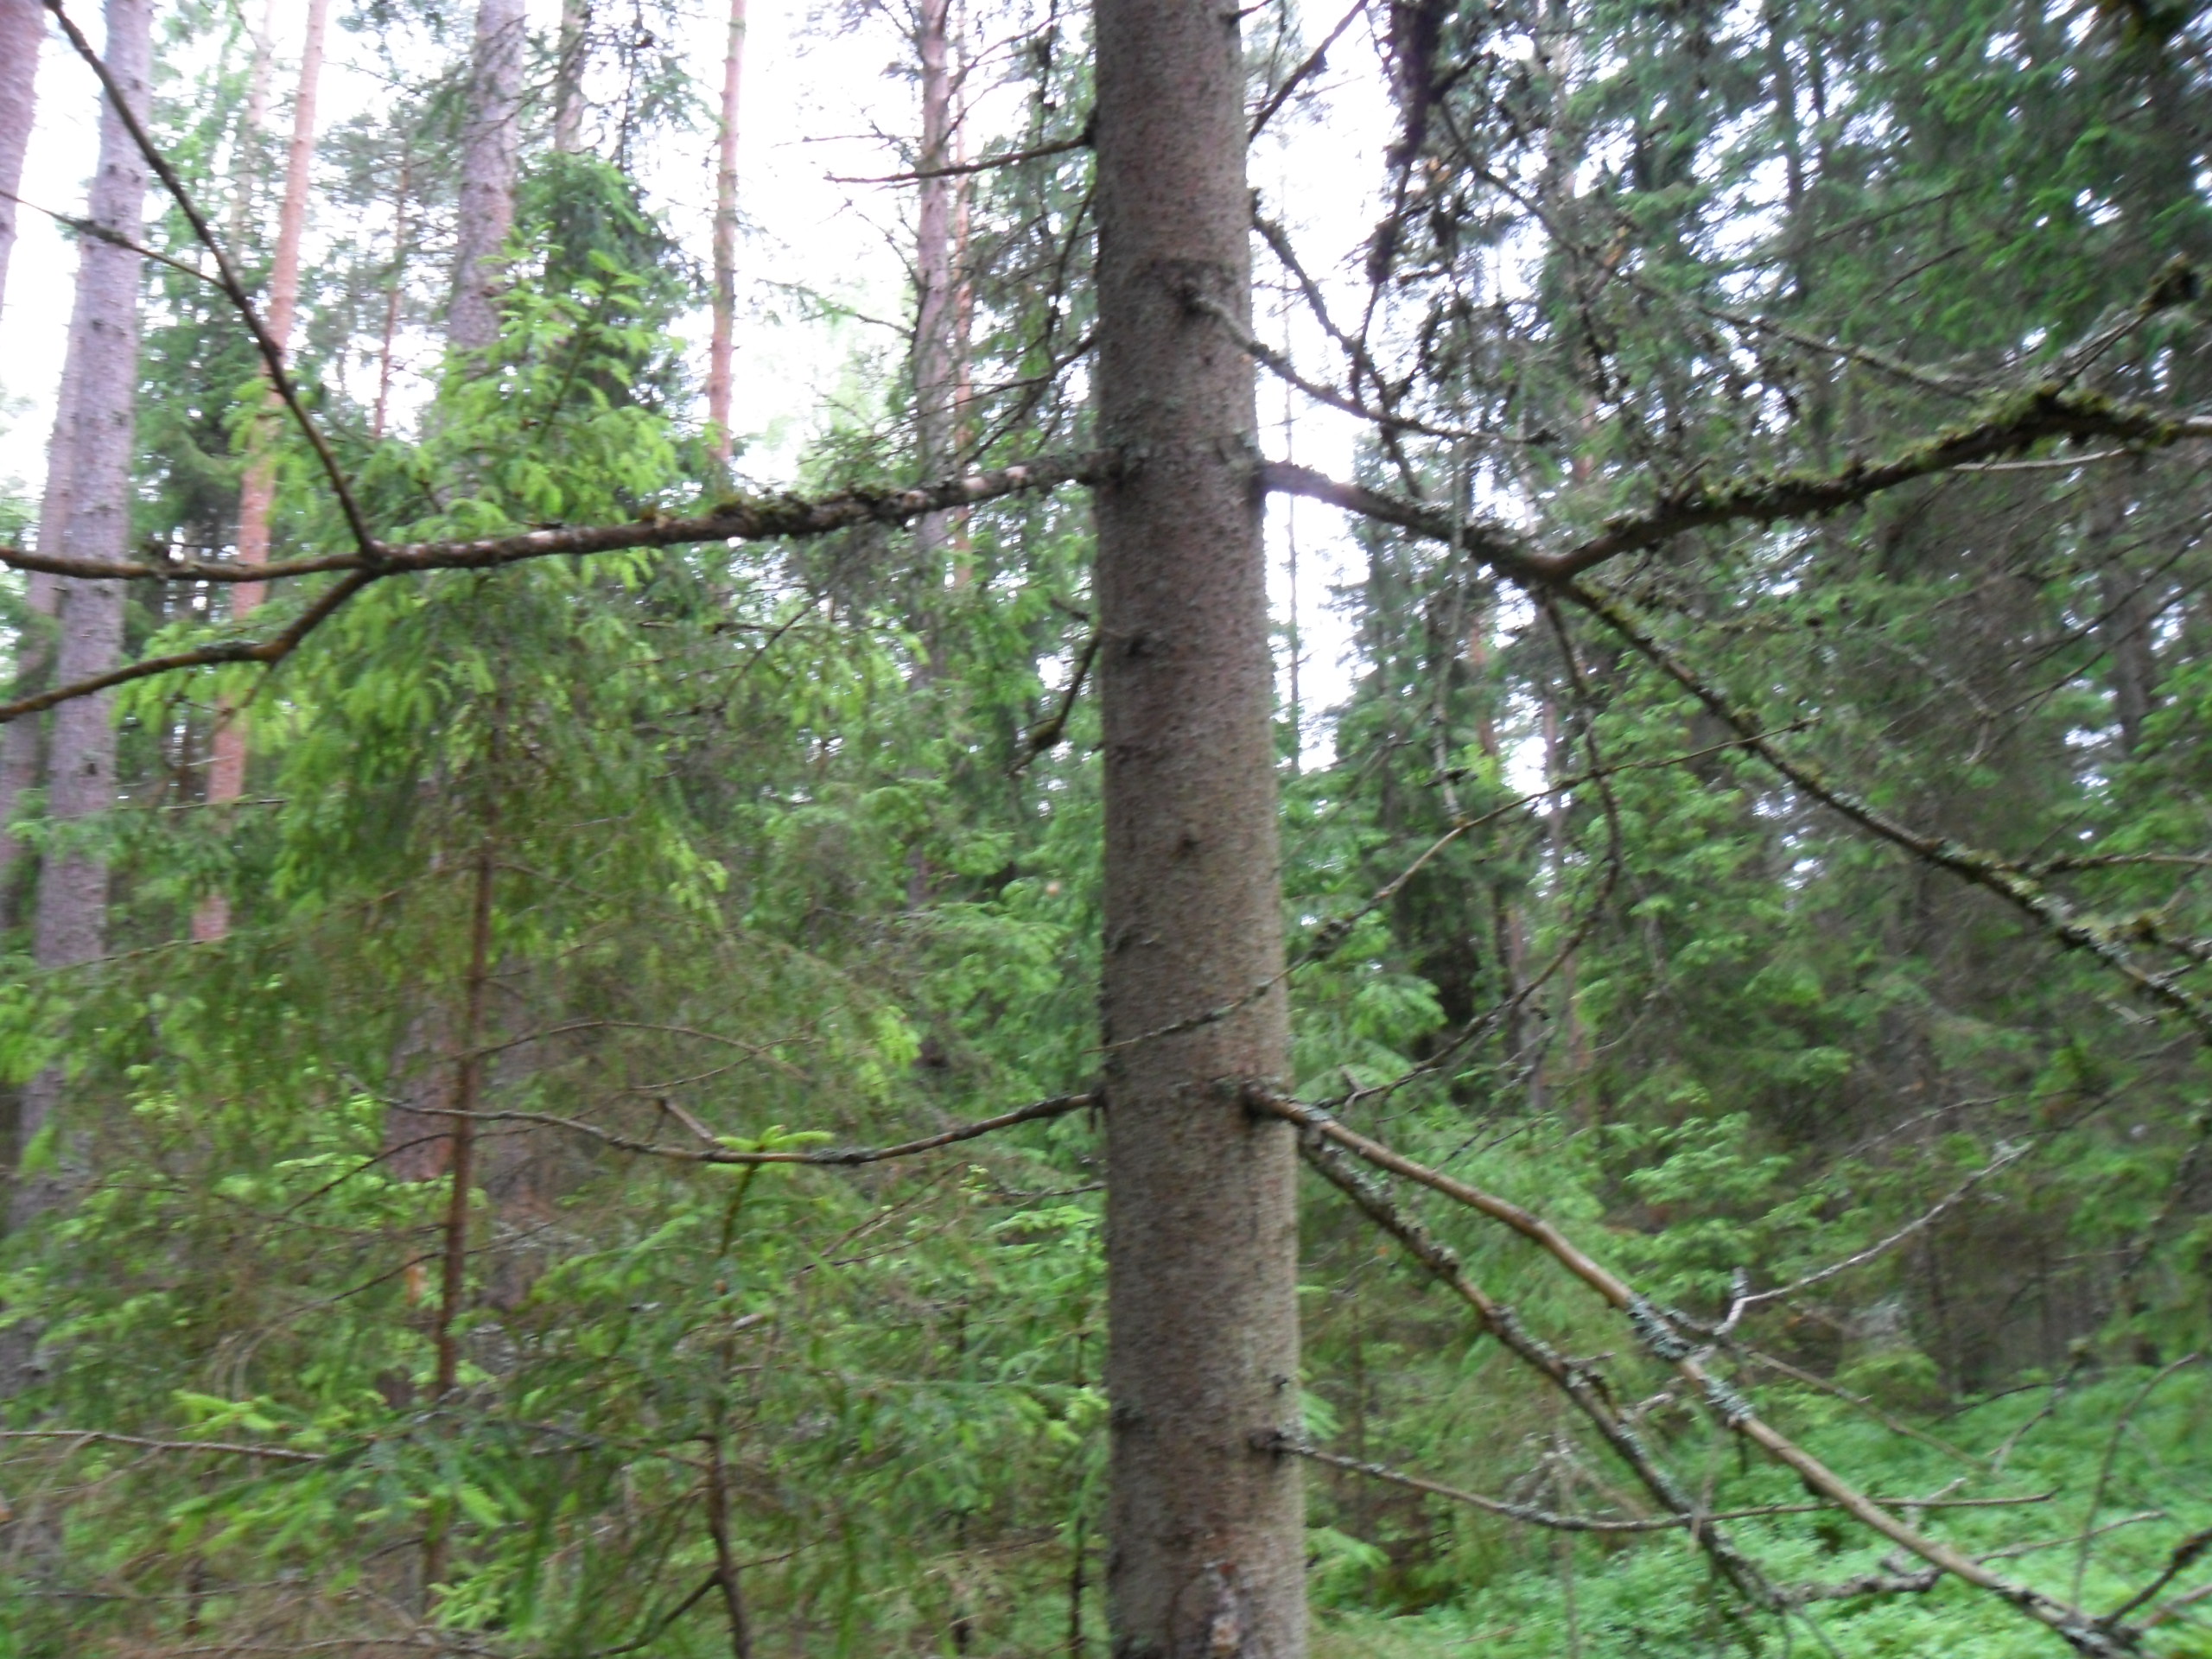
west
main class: Woodland
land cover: Other coniferous woodland
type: hemiboreal forest and nemoral coniferous forest and mixed broadleaved-coniferous forest
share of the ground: > 75 %
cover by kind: coniferous forest trees 75 %, herbaceous plants 25 %
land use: Forestry
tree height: > 5 m
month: June
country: LV
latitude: 57.2486
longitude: 22.1302
